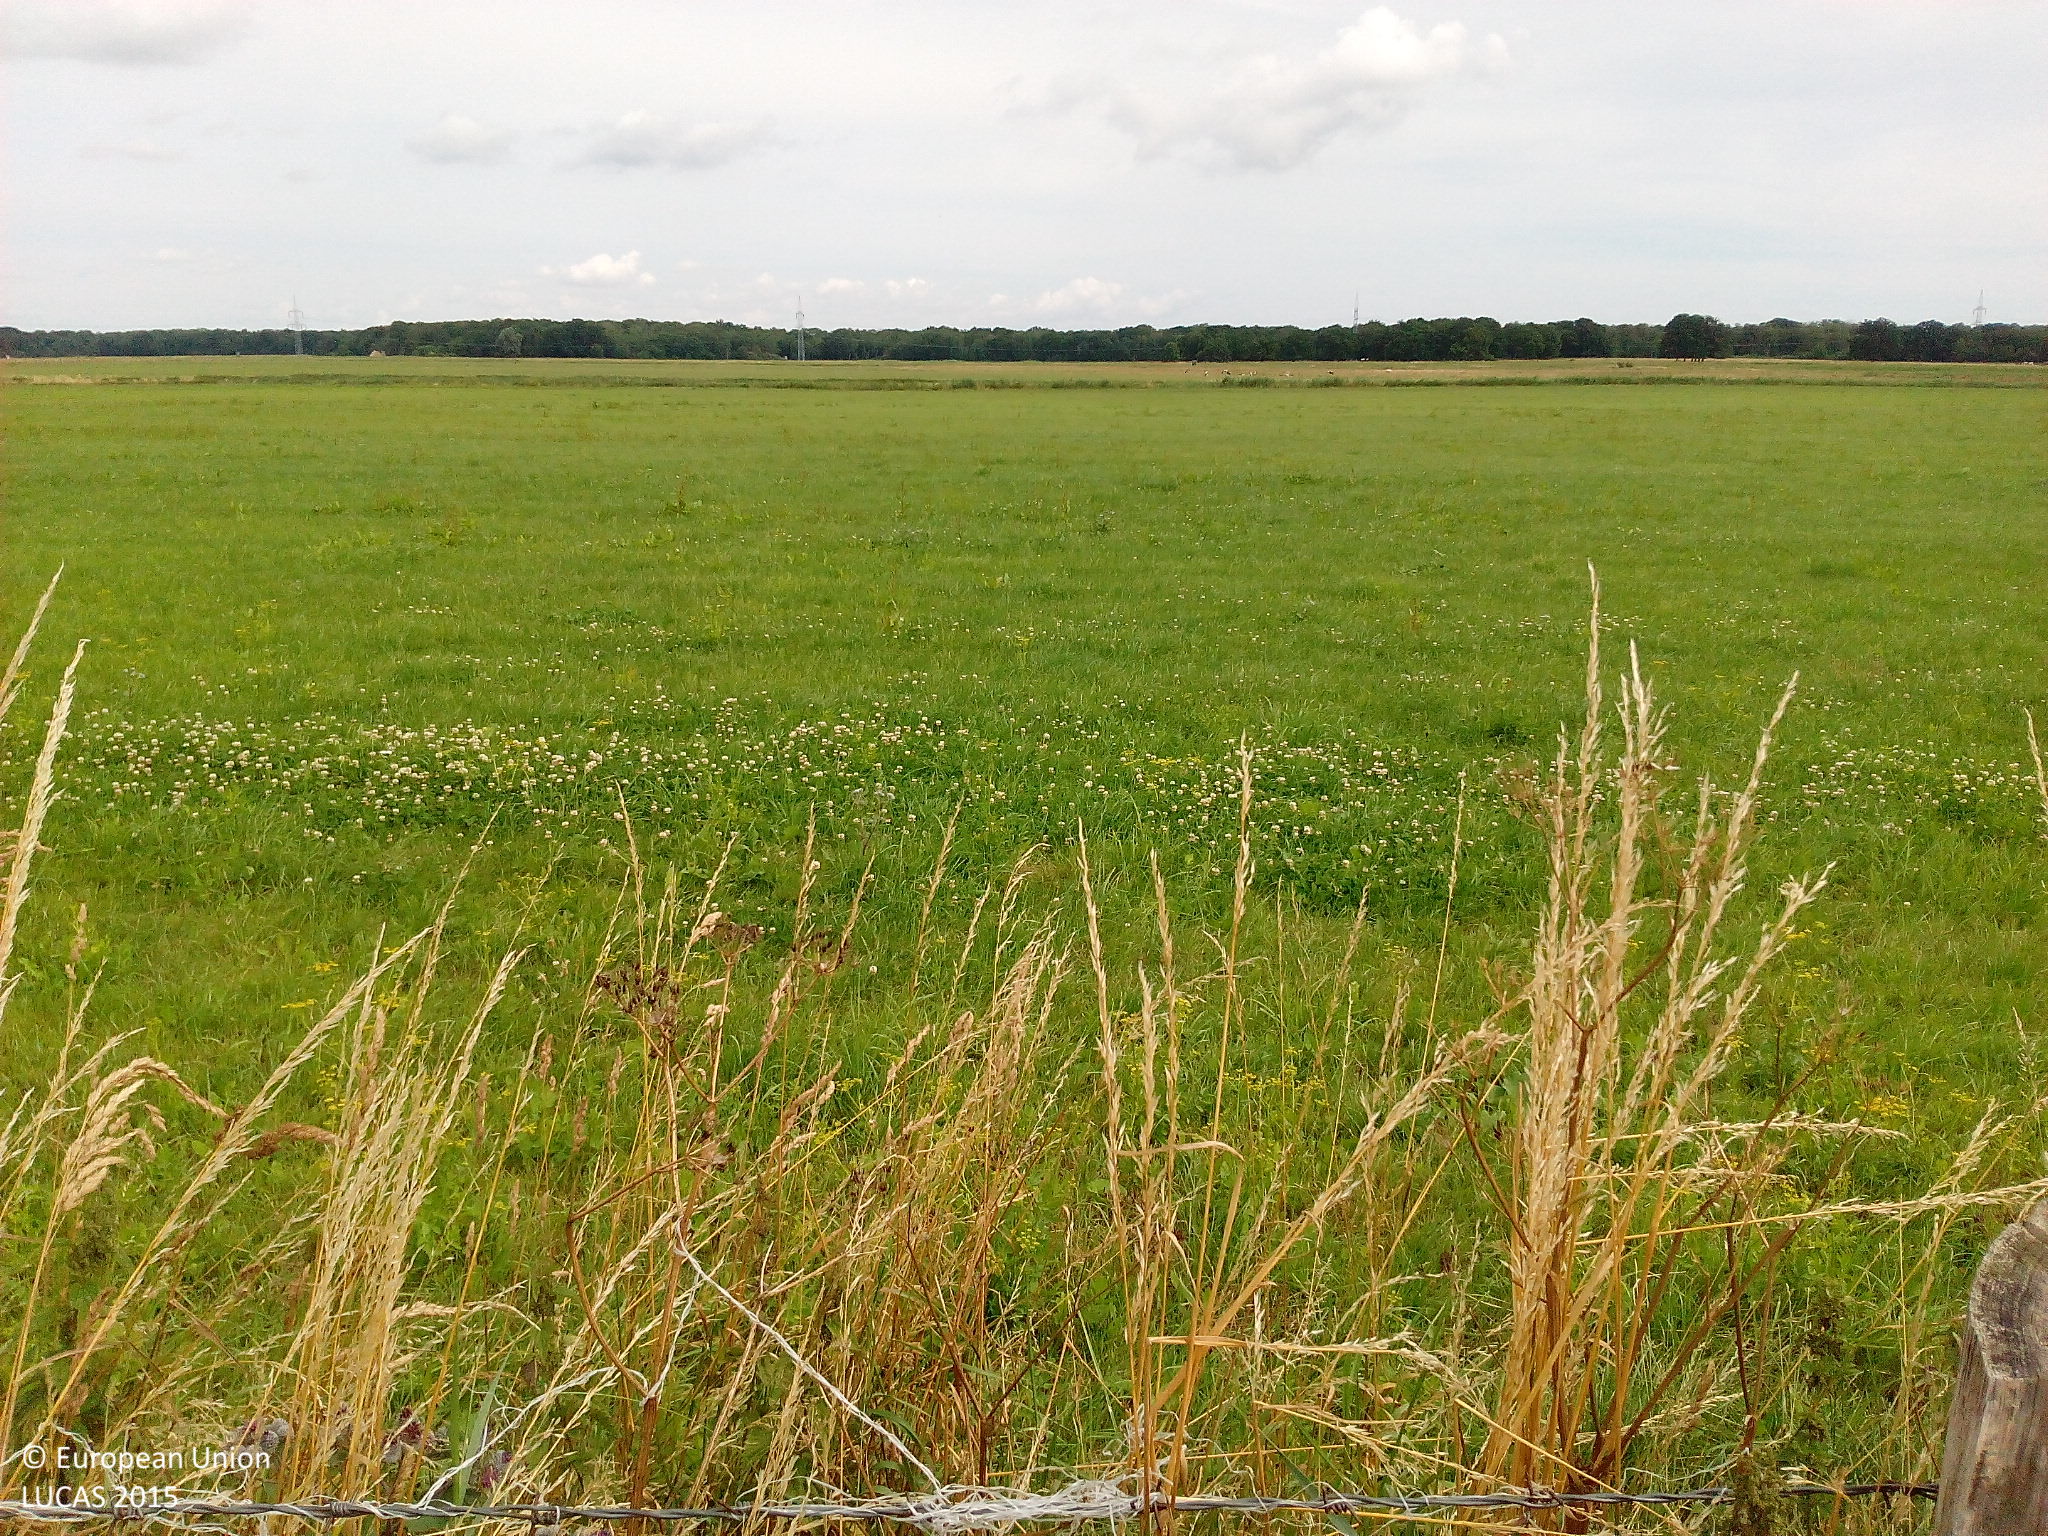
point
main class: Grassland
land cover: Grassland without tree/shrub cover
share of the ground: > 75 %
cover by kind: herbaceous plants 100 %
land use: Agriculture (excluding fallow land and kitchen gardens)
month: July
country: DE
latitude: 54.0949
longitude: 13.2868
